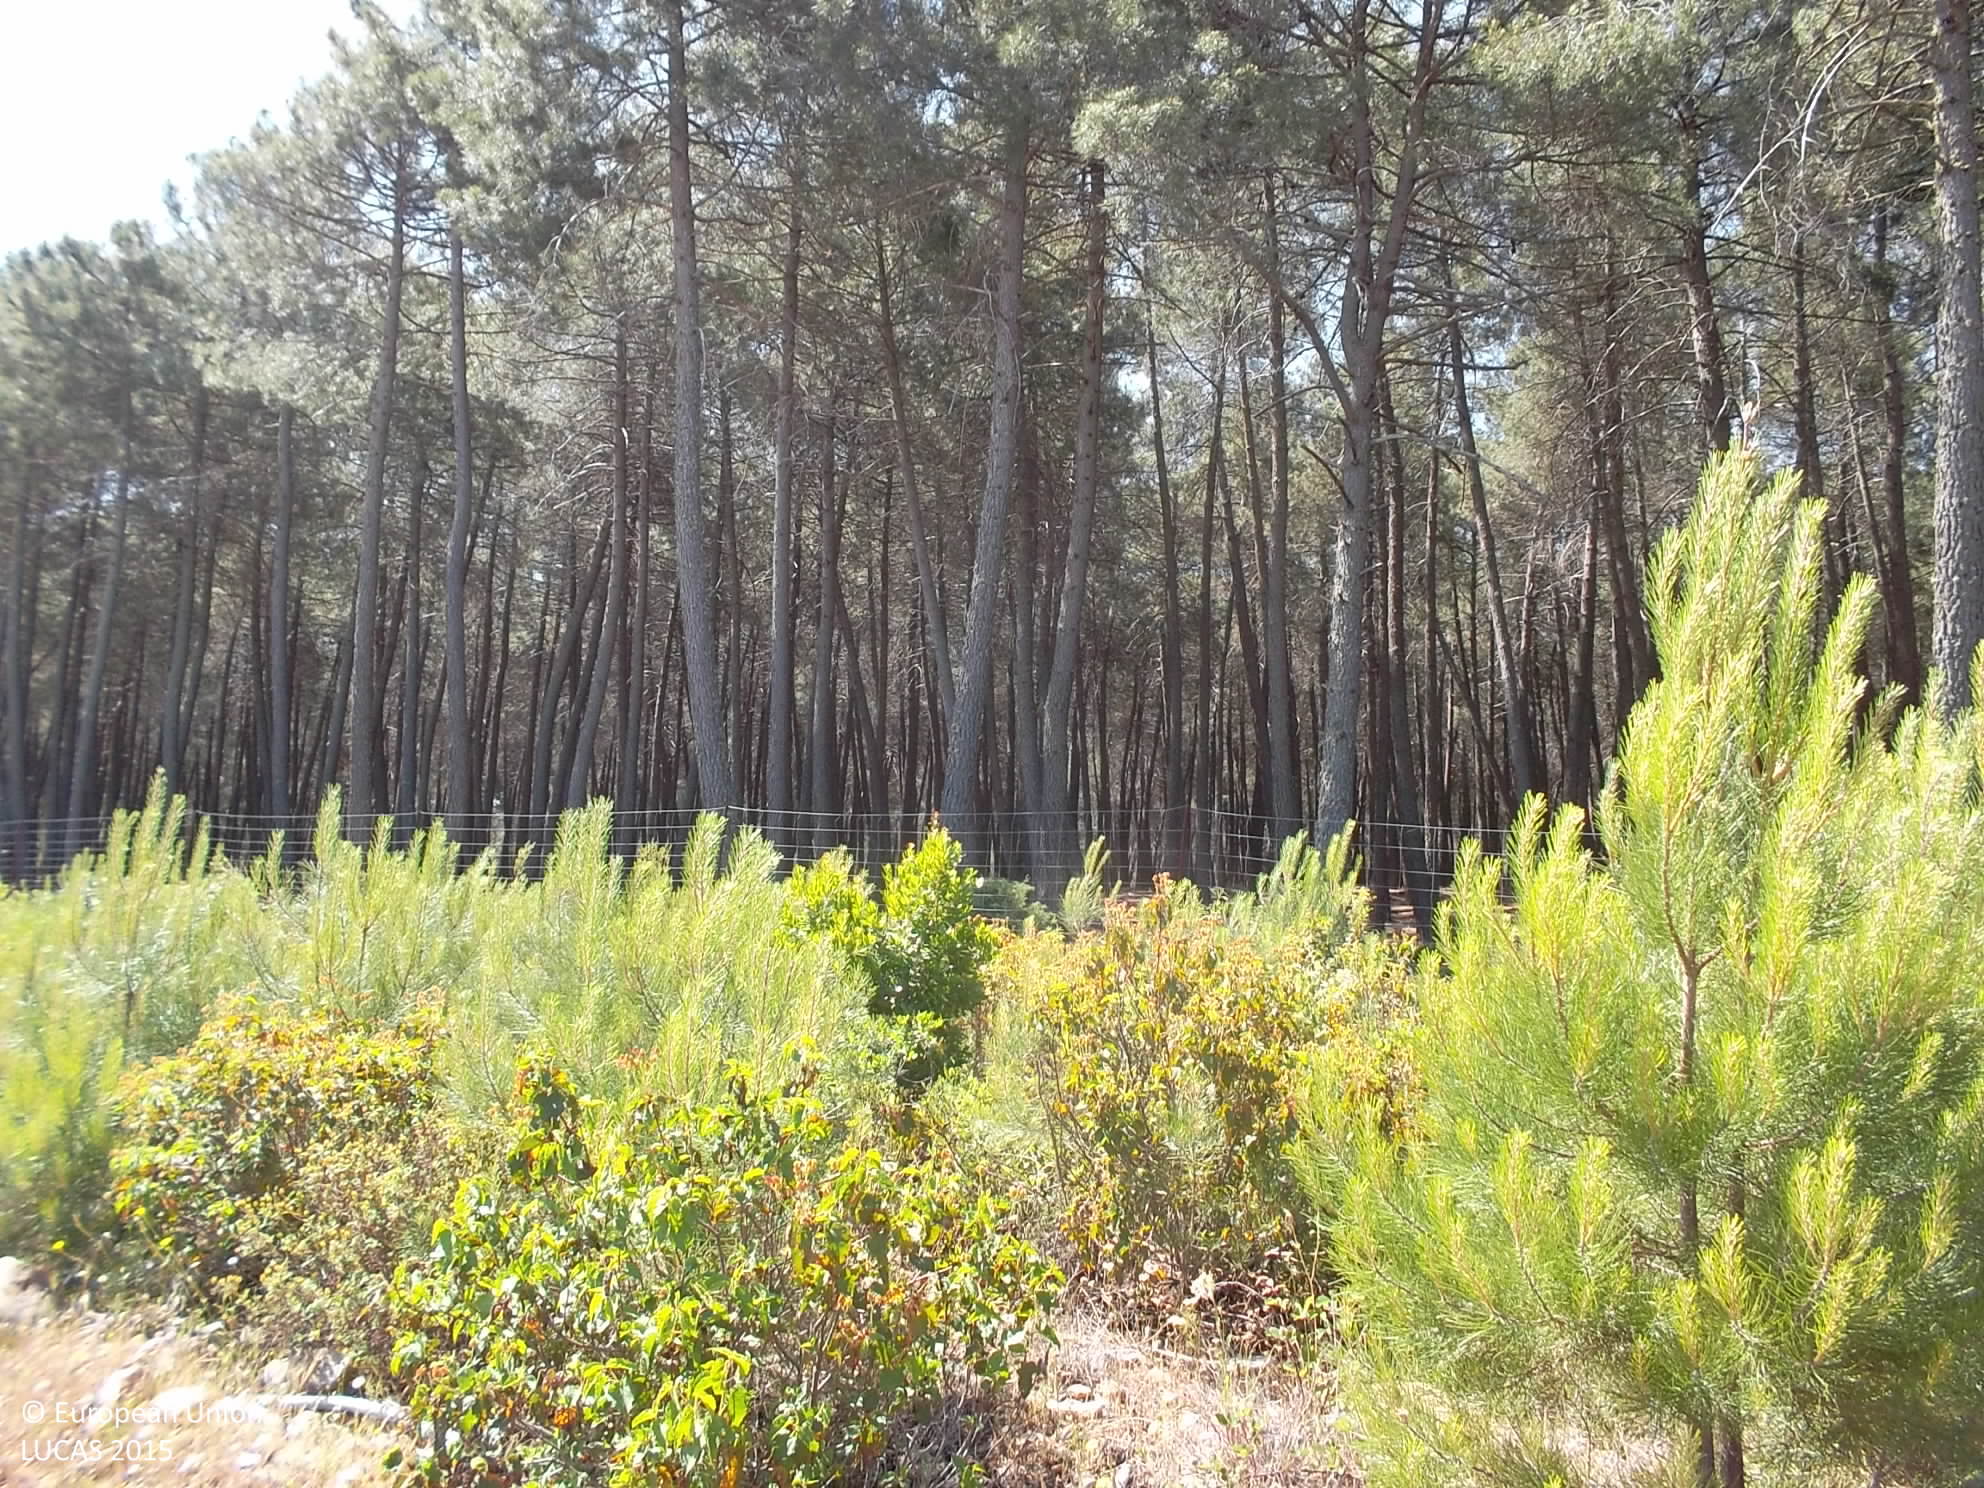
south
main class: Grassland
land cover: Grassland without tree/shrub cover
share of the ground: 50 - 75 %
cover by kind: herbaceous plants 75 %, unconsolidated bare surface 20 %, shrubs 5 %
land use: Protection infrastructures
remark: Fire break
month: May
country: ES
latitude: 38.4711
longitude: -4.3569
